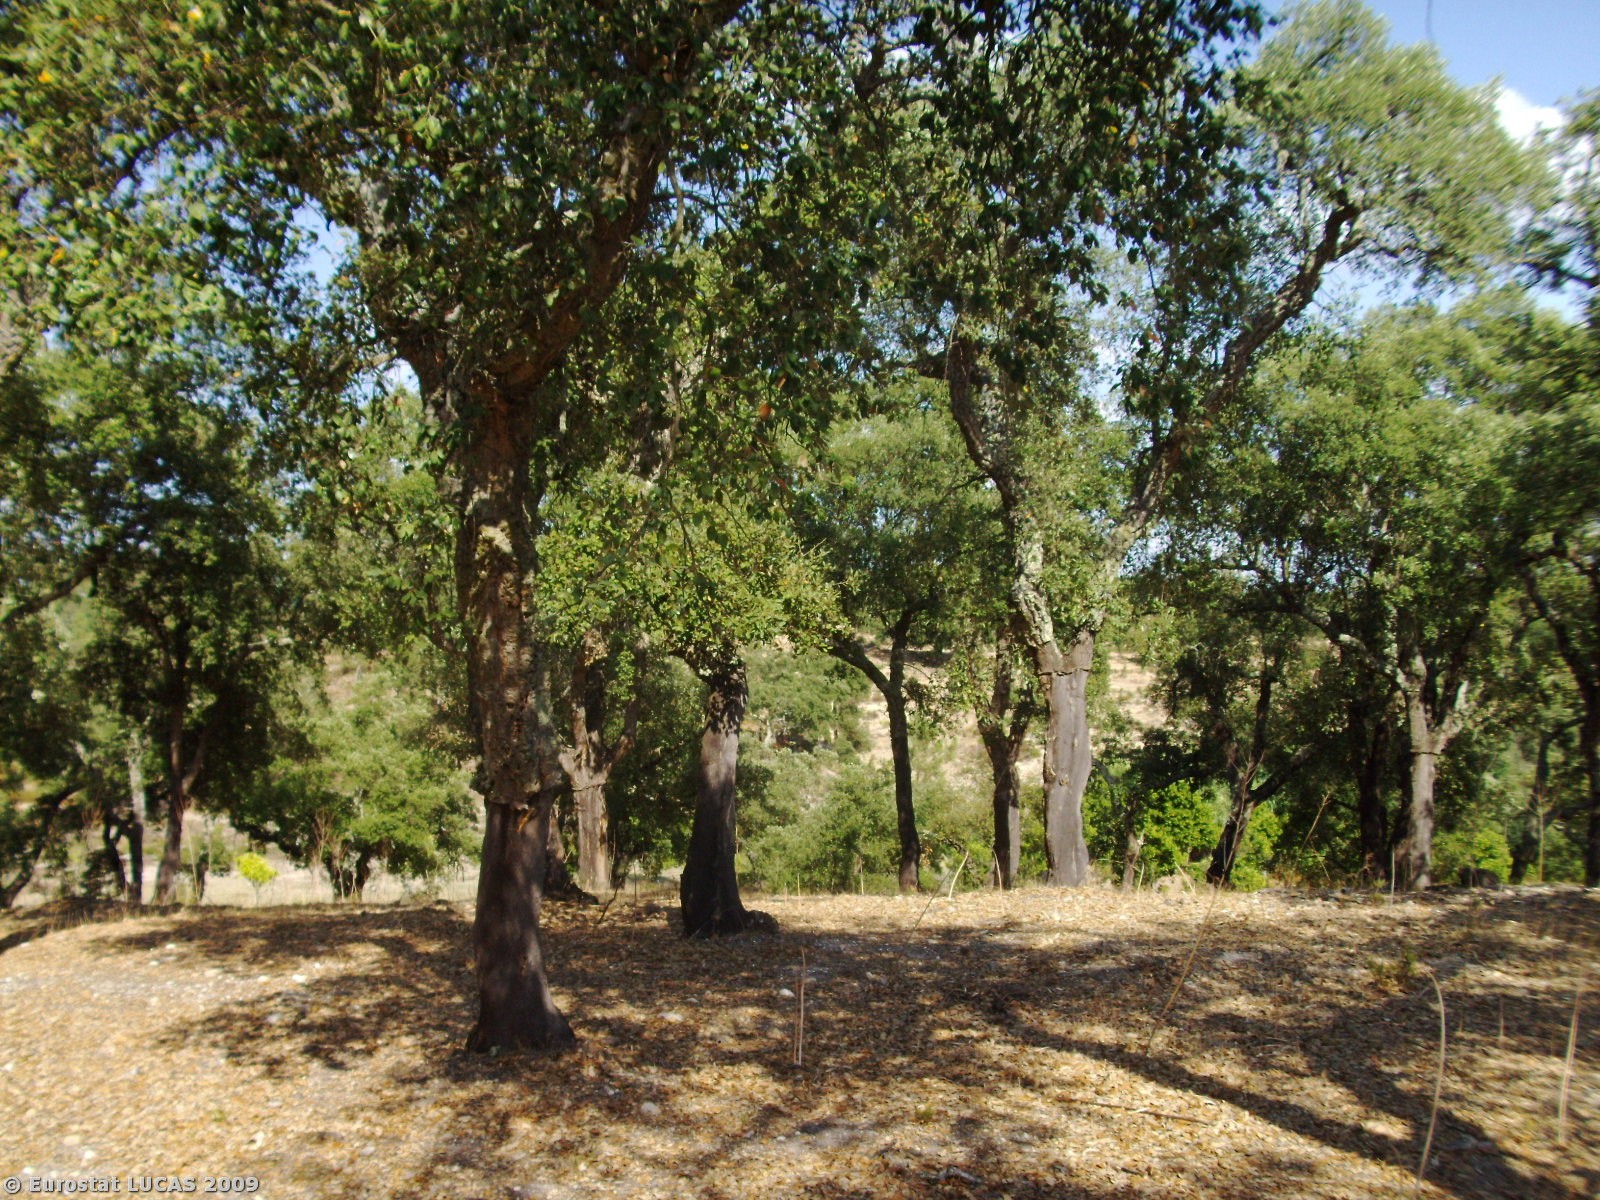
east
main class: Woodland
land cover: Broadleaved woodland
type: broadleaved evergreen forest
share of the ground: > 75 %
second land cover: Spontaneously vegetated surfaces
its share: 10 - 25 %
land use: Forestry
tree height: > 5 m
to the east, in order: Broadleaved woodland; Spontaneously vegetated surfaces; Broadleaved woodland; Grass margins; Tracks; Grass margins; Other citrus fruit; Shruby margins; Rivers and streams; Shruby margins; Broadleaved woodland; Spontaneously vegetated surfaces; Broadleaved woodland; Tracks; Broadleaved woodland
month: August
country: PT
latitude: 39.3218
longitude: -8.0240
